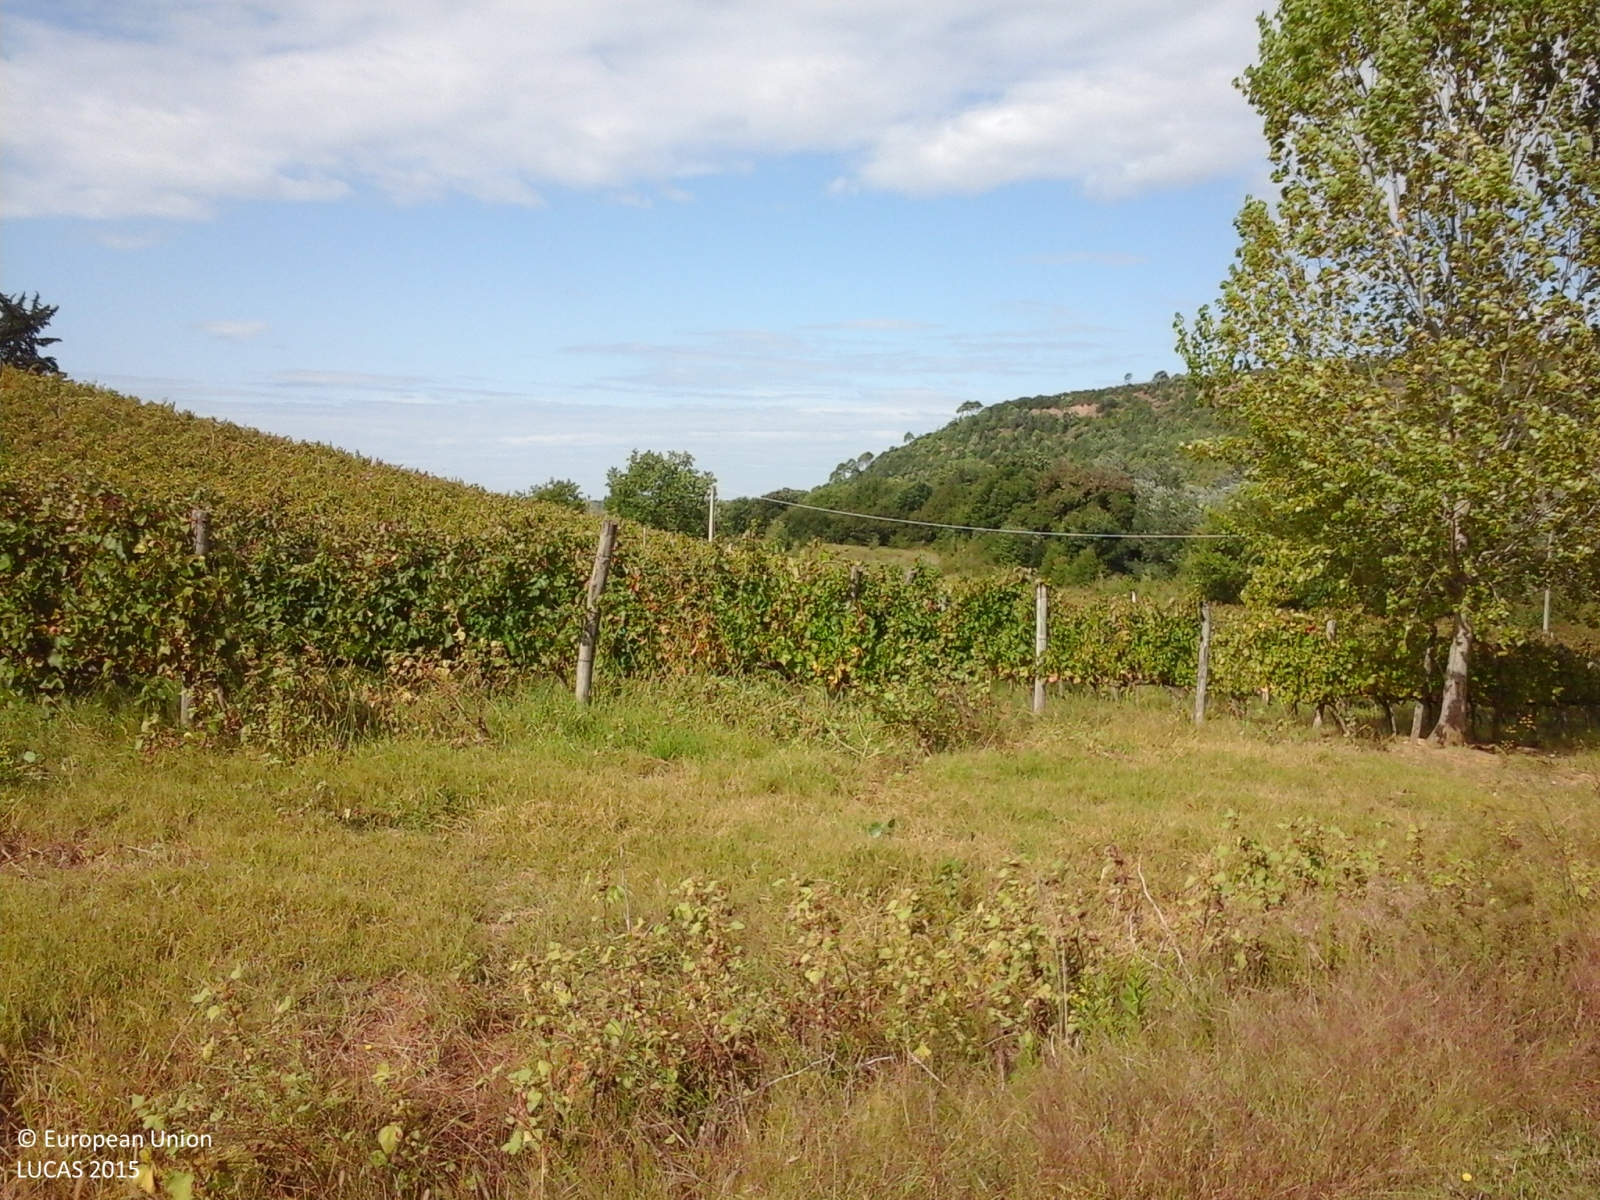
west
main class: Cropland
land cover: Vineyards
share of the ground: > 75 %
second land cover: Grassland without tree/shrub cover
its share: > 75 %
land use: Agriculture (excluding fallow land and kitchen gardens)
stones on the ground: < 10 %
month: August
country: IT
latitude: 43.3384
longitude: 10.6026
